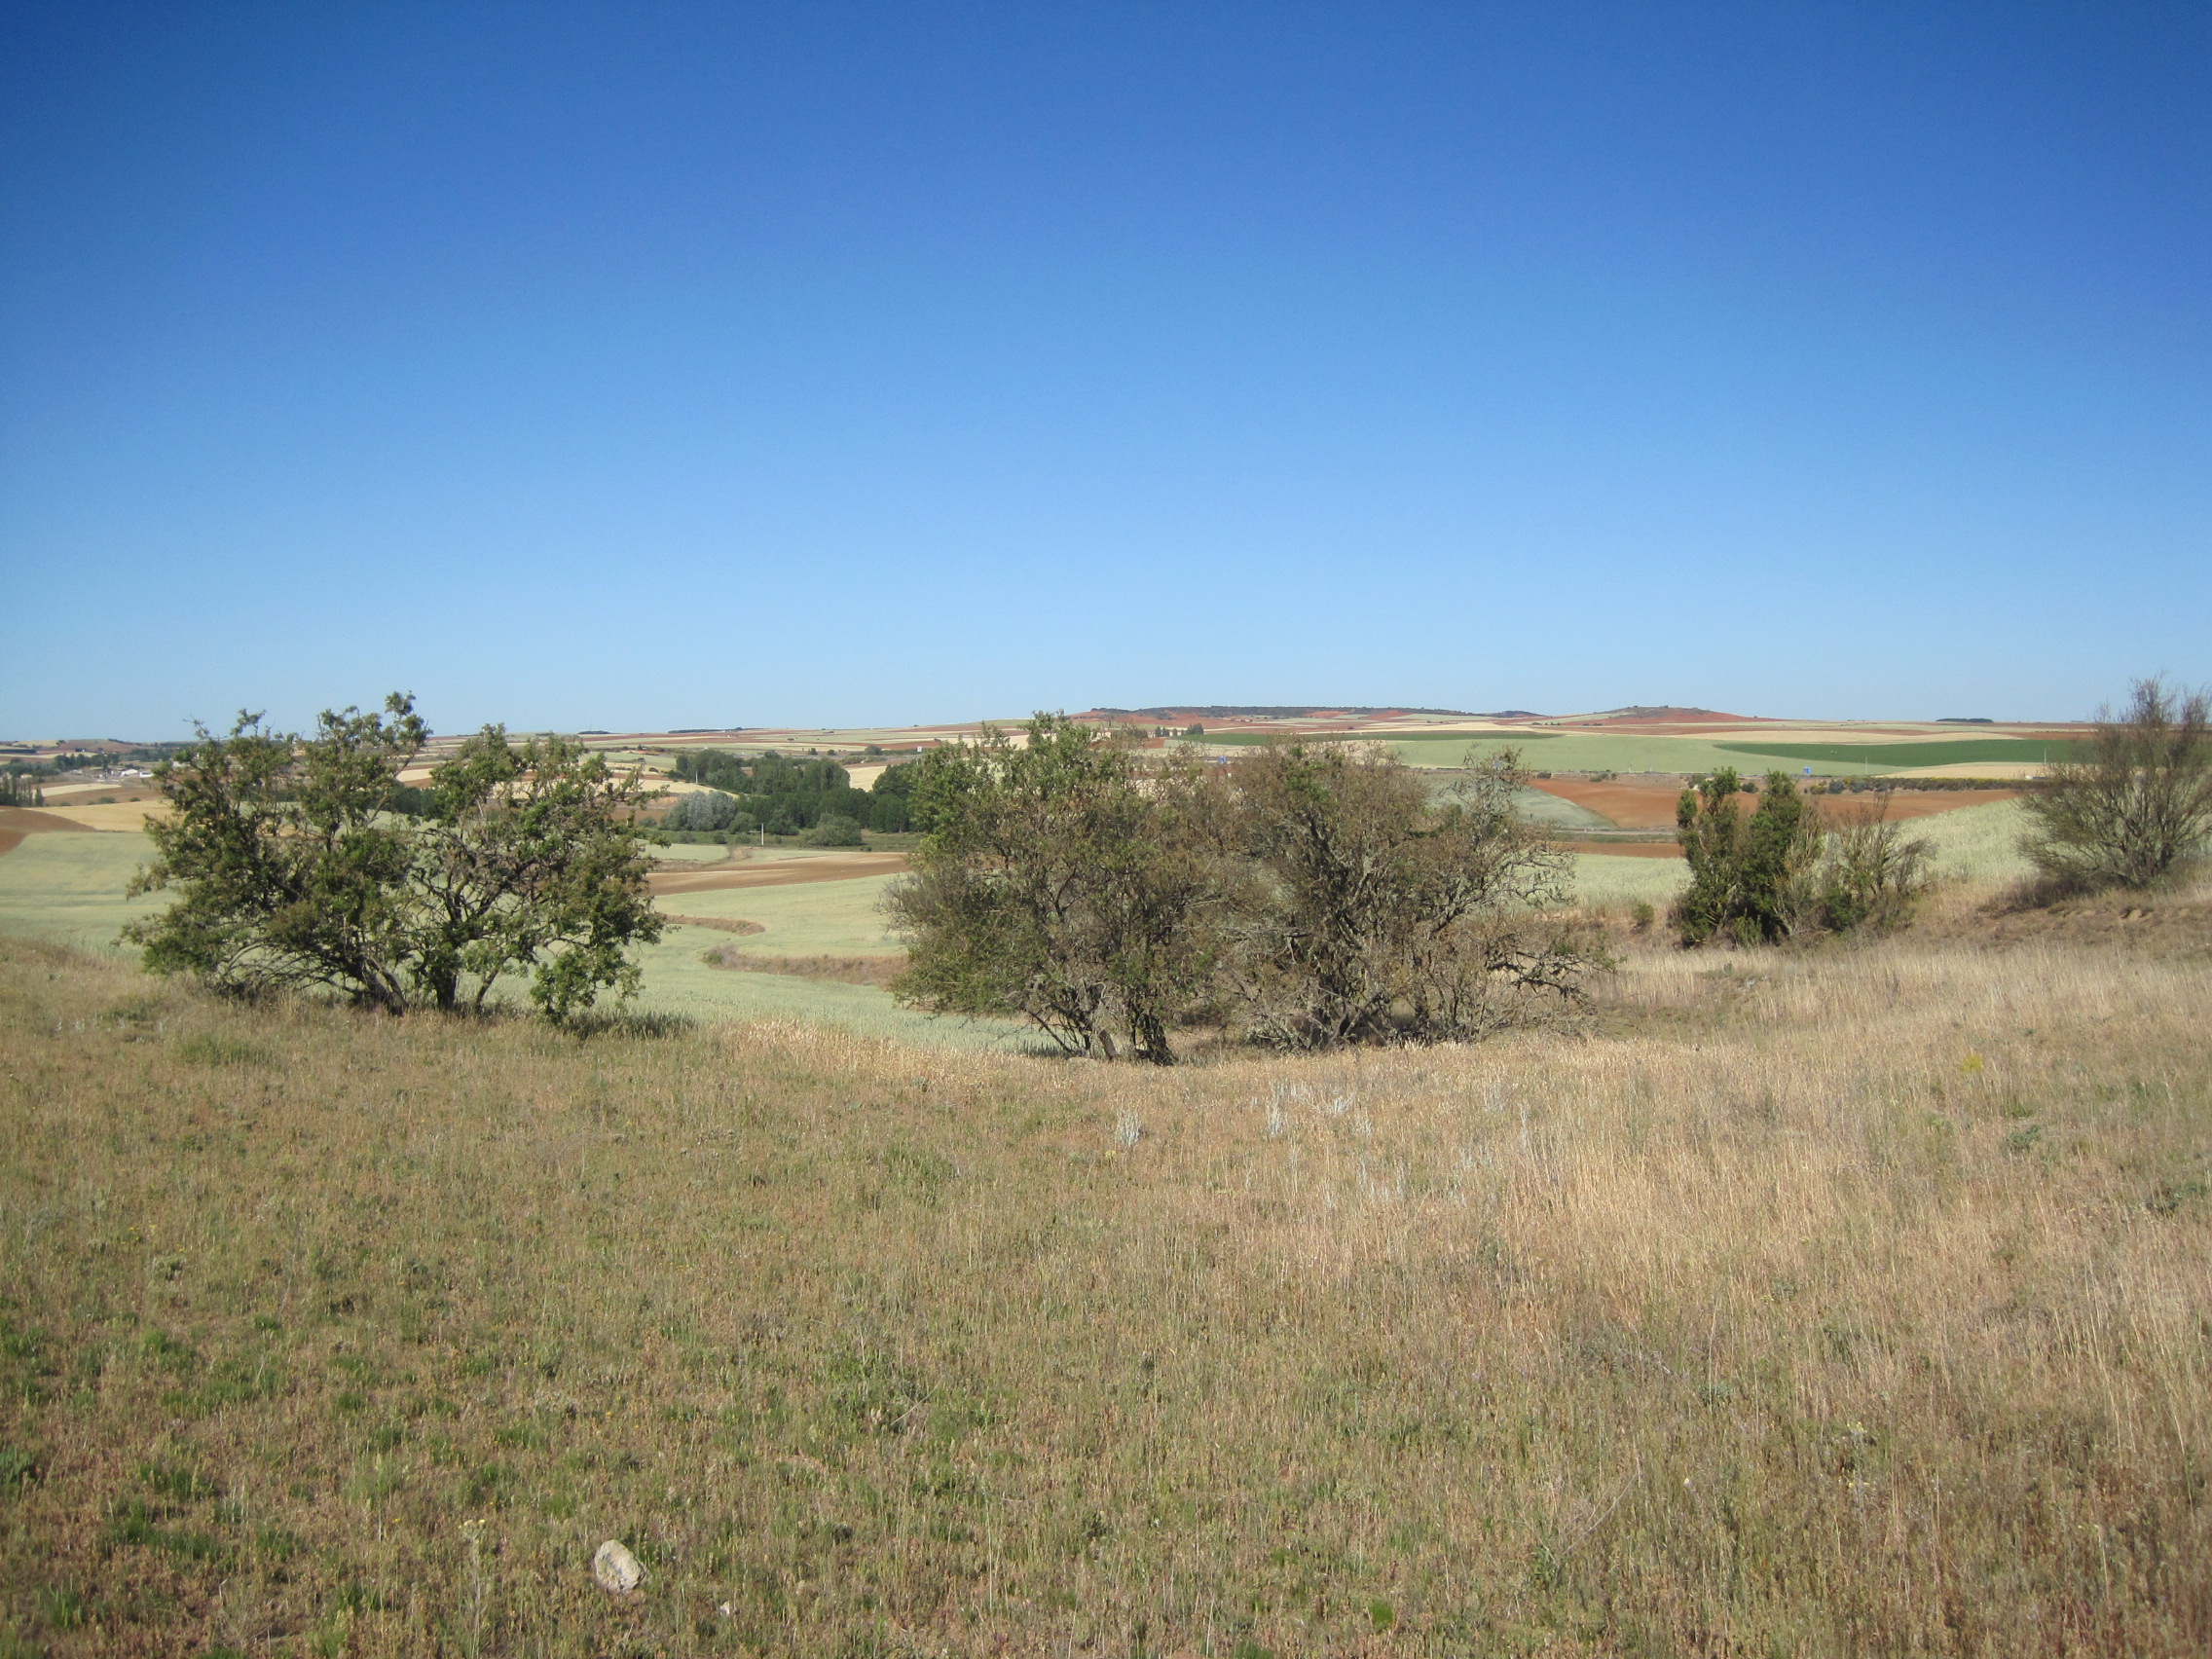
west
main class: Grassland
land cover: Grassland with sparse tree/shrub cover
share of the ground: > 75 %
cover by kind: herbaceous plants 95 %, broadleaved forest trees 5 %
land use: Semi-natural and natural areas not in use
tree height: < 5 m
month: May
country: ES
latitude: 41.1829
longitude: -5.3456
